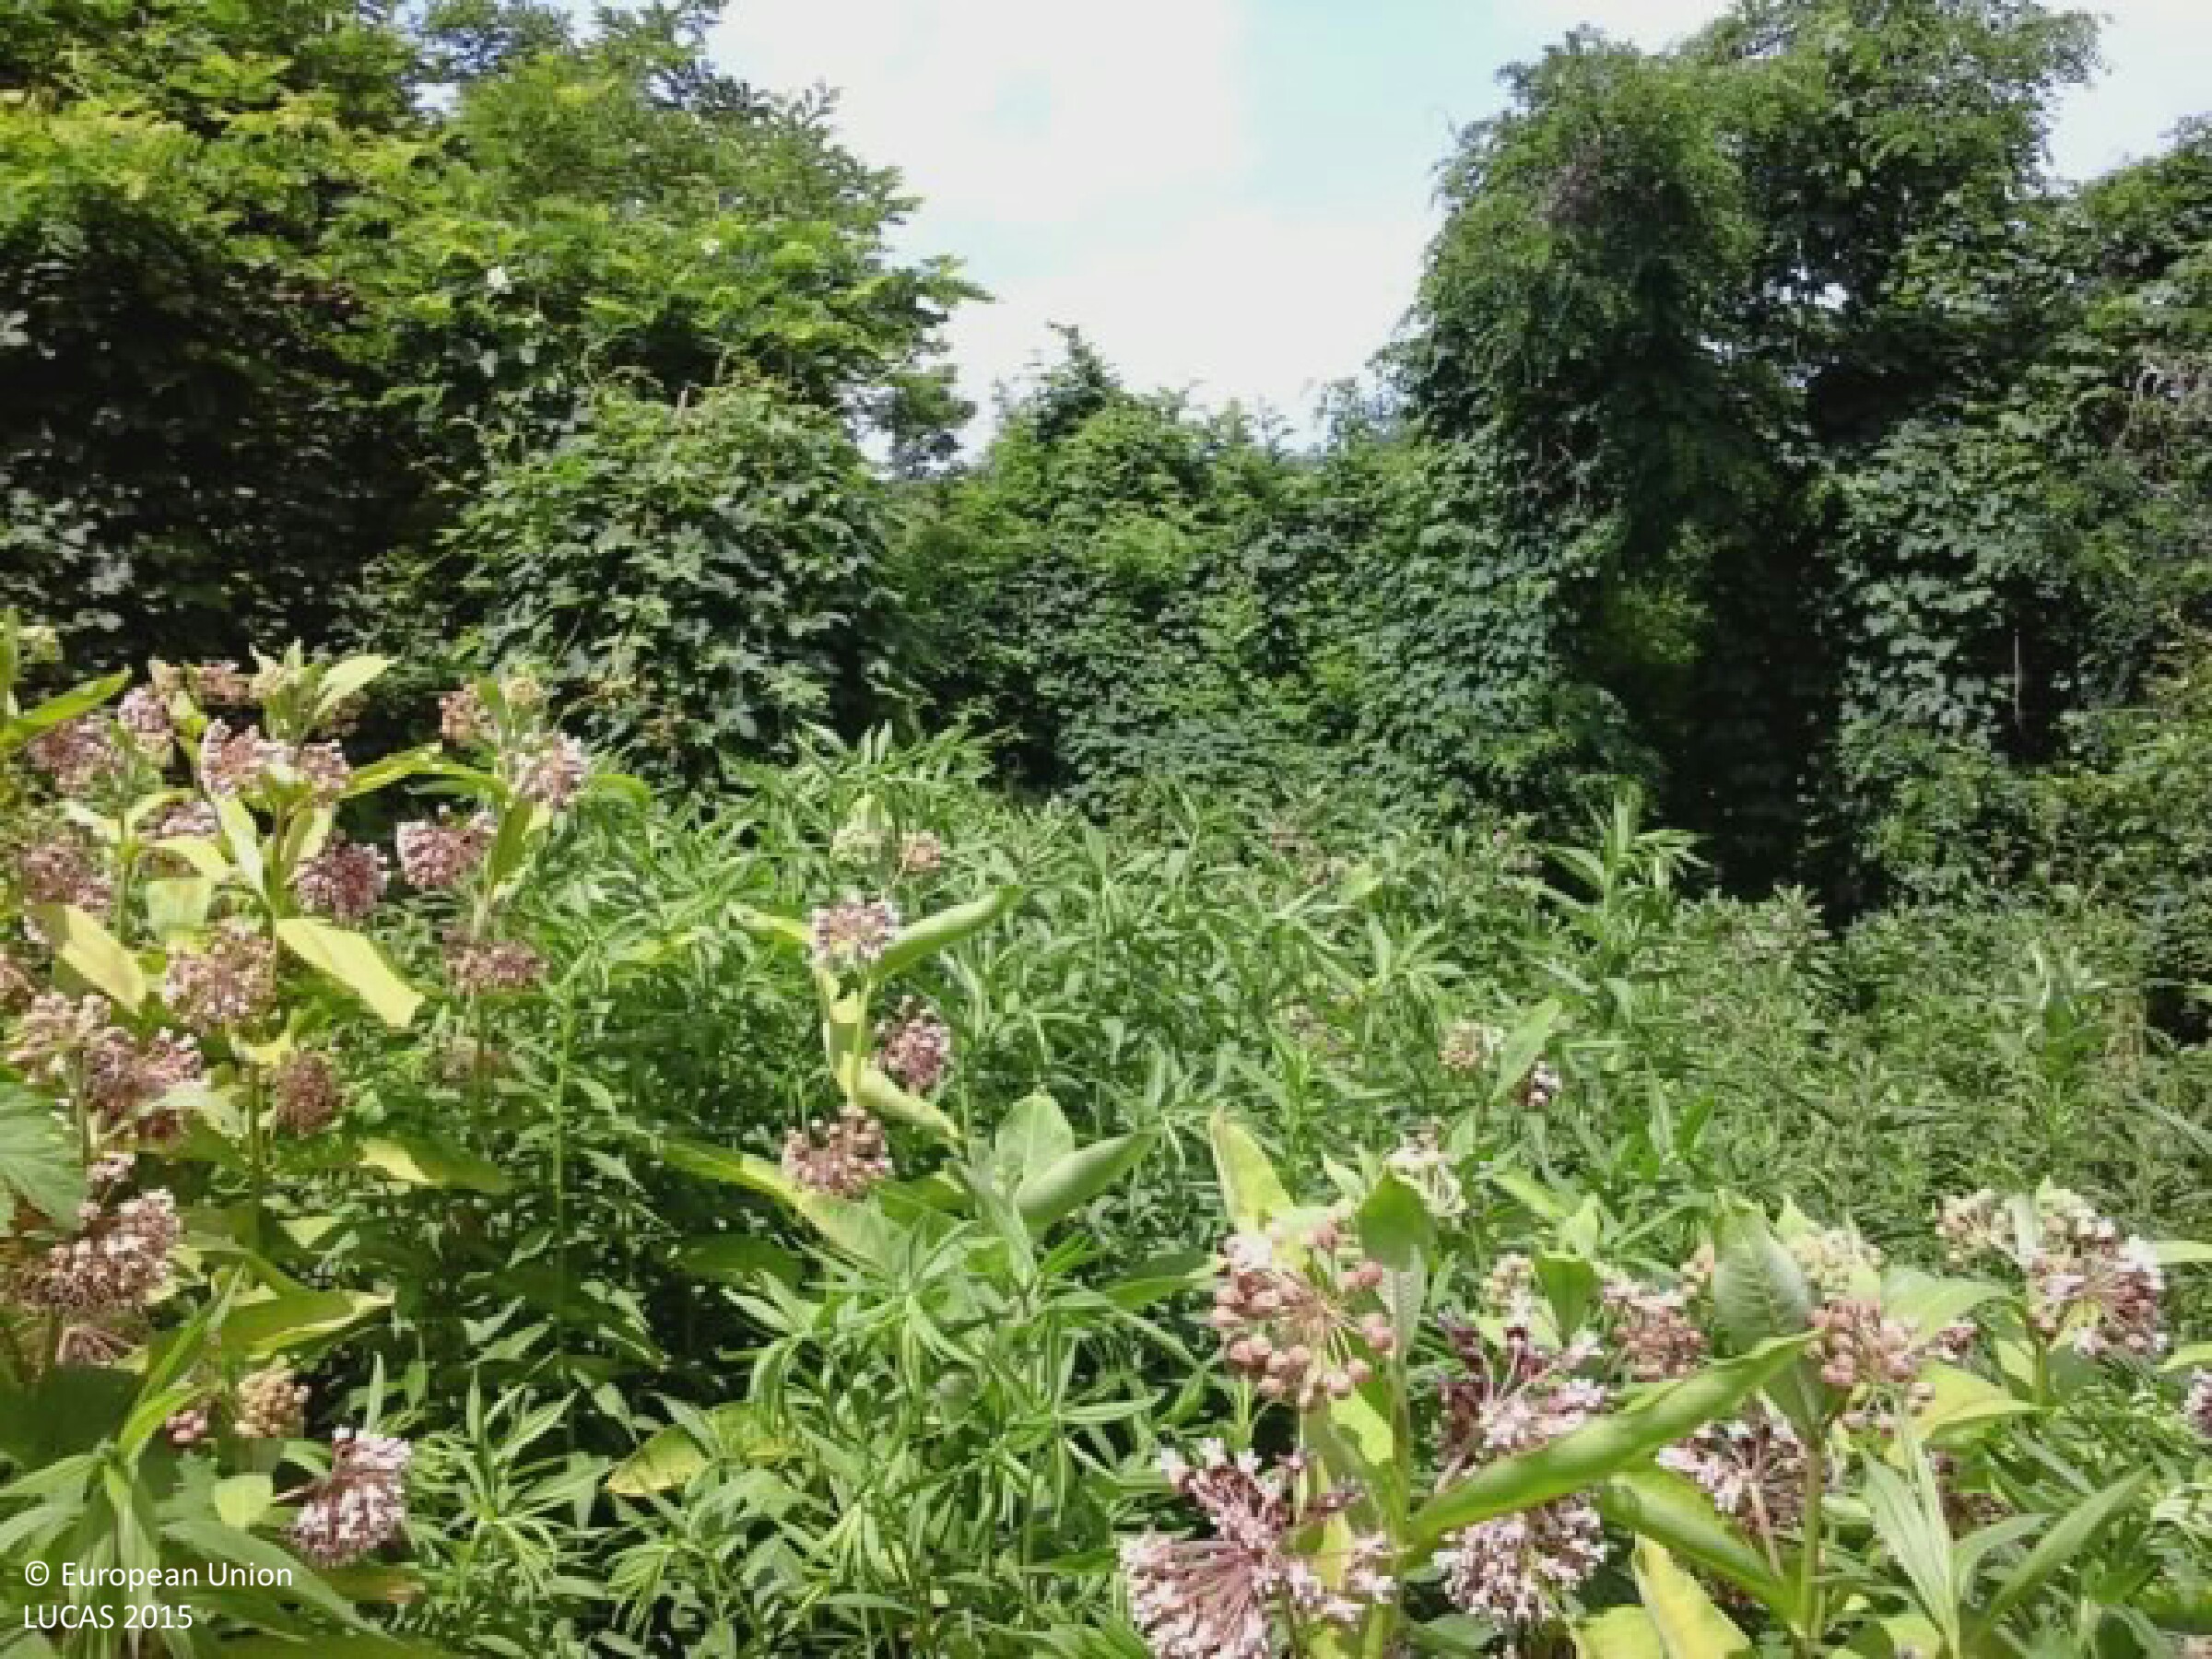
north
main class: Shrubland
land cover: Shrubland with sparse tree cover
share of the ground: > 75 %
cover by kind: shrubs 65 %, herbaceous plants 30 %, broadleaved forest trees 5 %
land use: Semi-natural and natural areas not in use
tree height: > 5 m
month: June
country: HU
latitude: 47.5371
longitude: 19.3327
